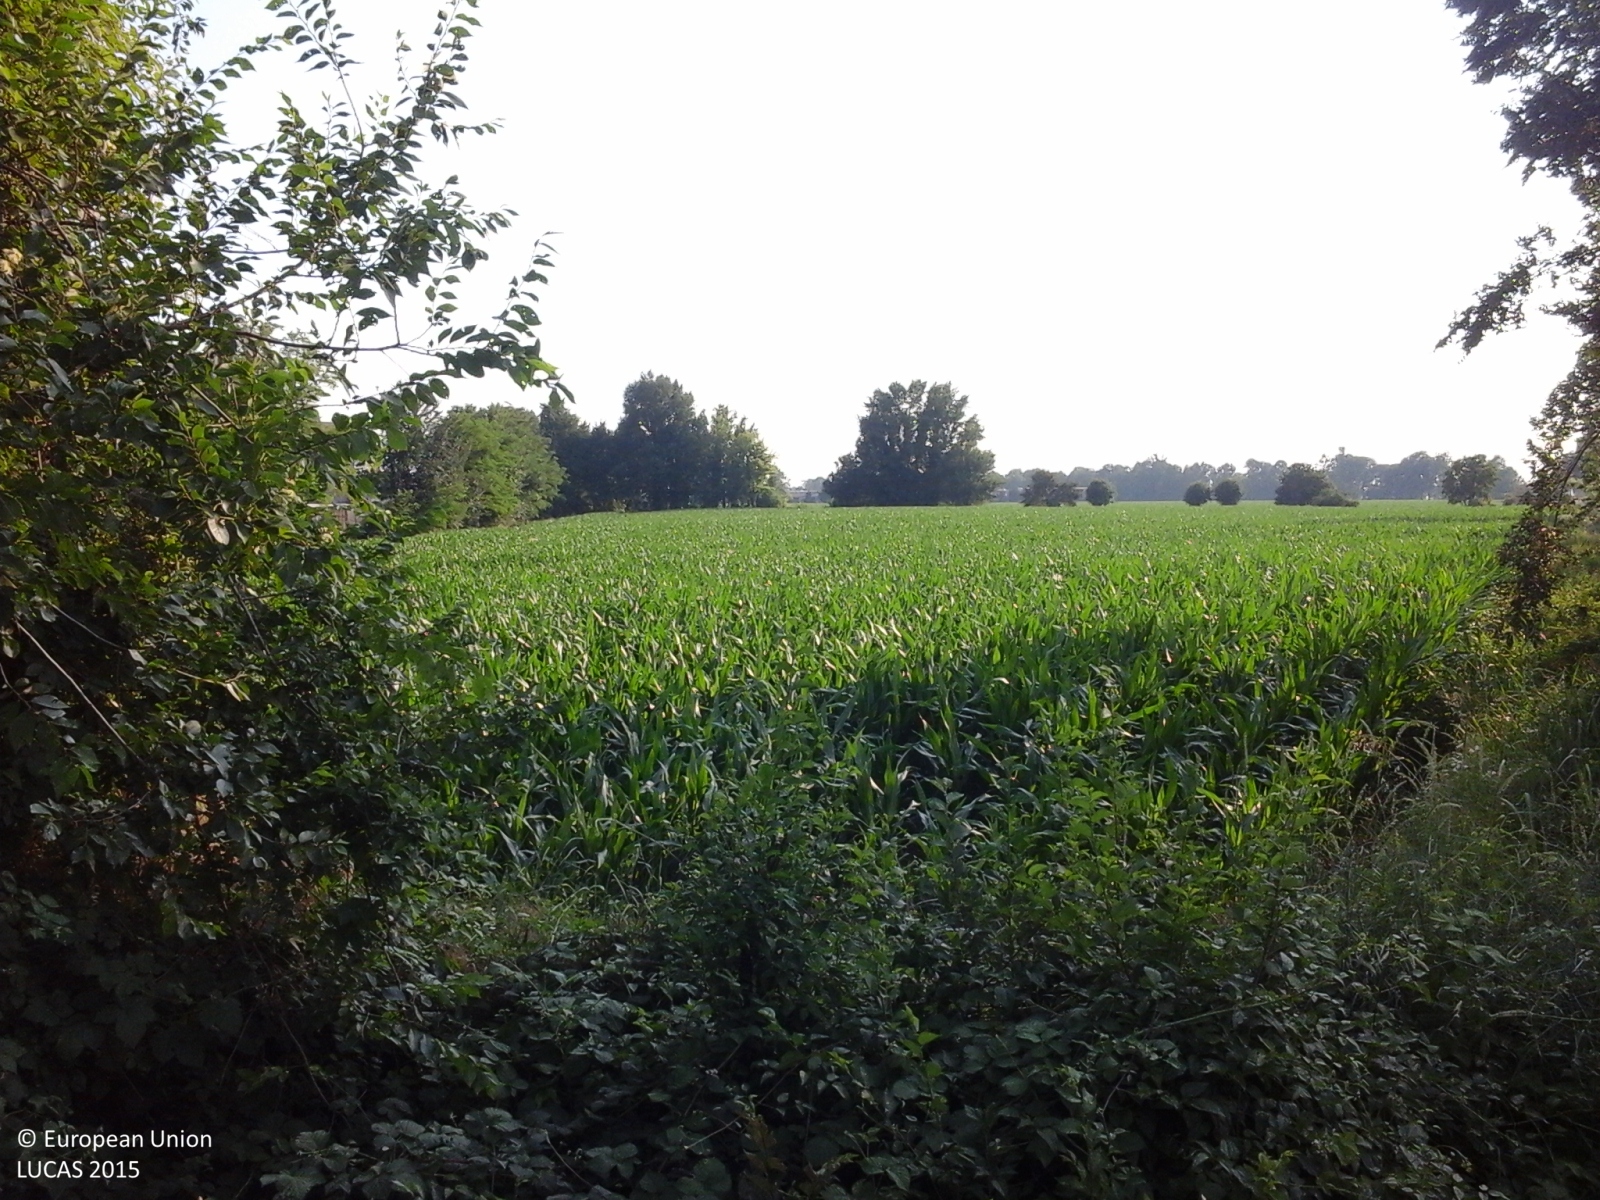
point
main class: Cropland
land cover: Maize
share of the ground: > 75 %
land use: Agriculture (excluding fallow land and kitchen gardens)
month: June
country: IT
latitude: 45.3778
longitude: 10.2932
